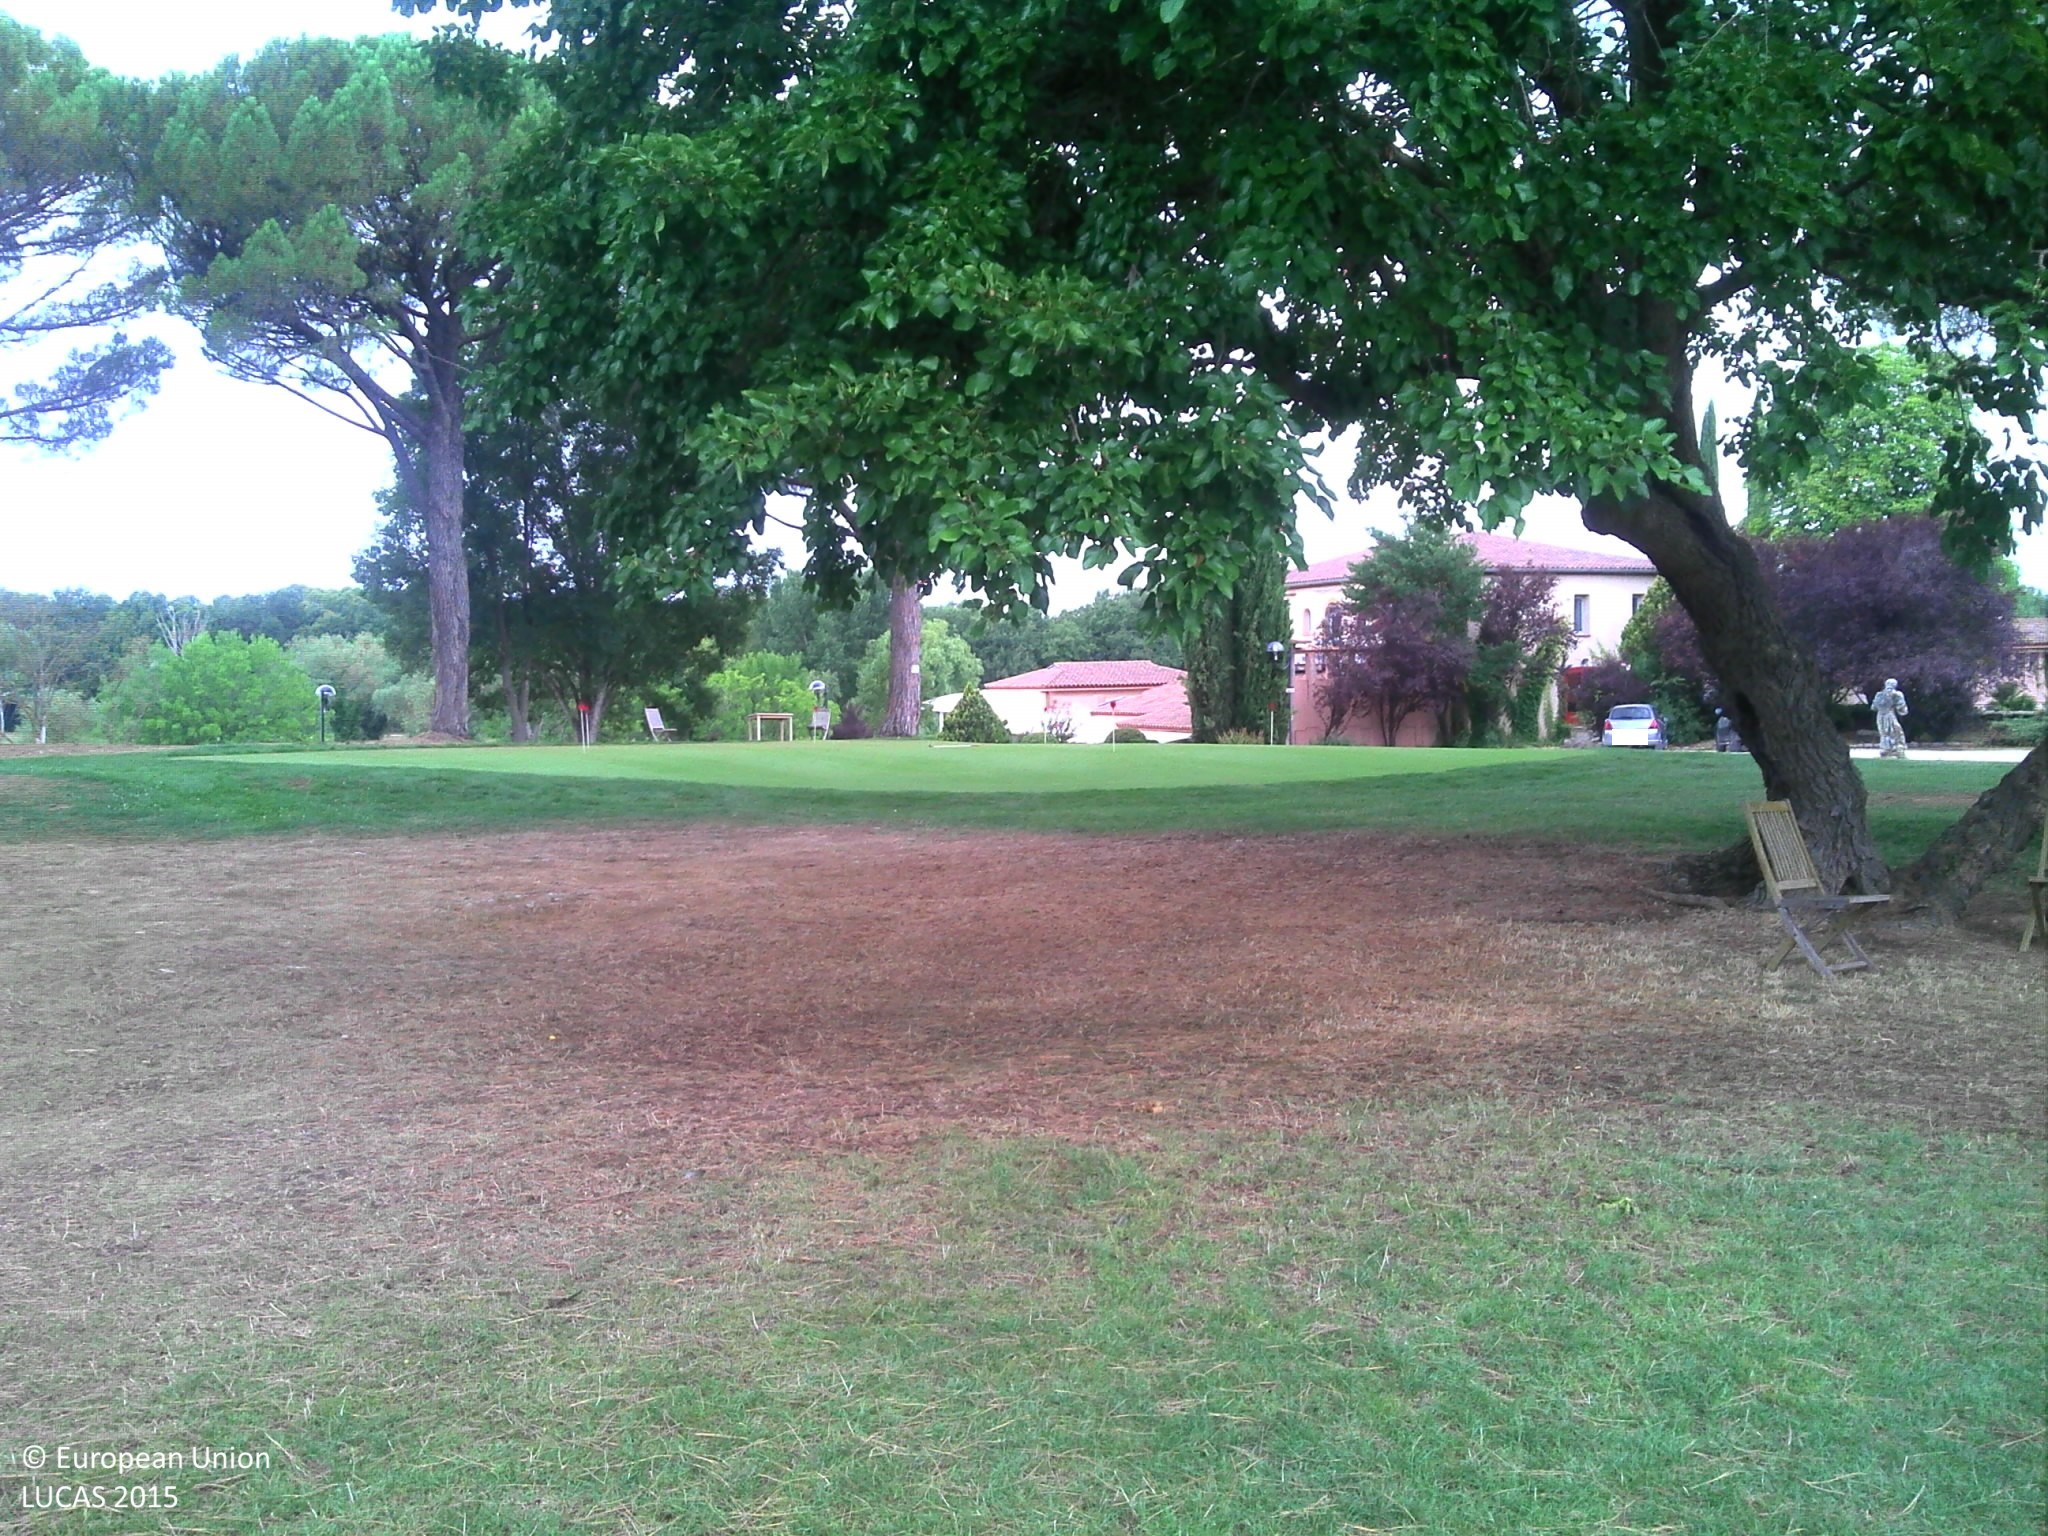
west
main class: Grassland
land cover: Grassland with sparse tree/shrub cover
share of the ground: > 75 %
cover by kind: herbaceous plants 85 %, unconsolidated bare surface 10 %, broadleaved forest trees 5 %
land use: Sport
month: August
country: FR
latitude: 43.4622
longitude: 5.5973
